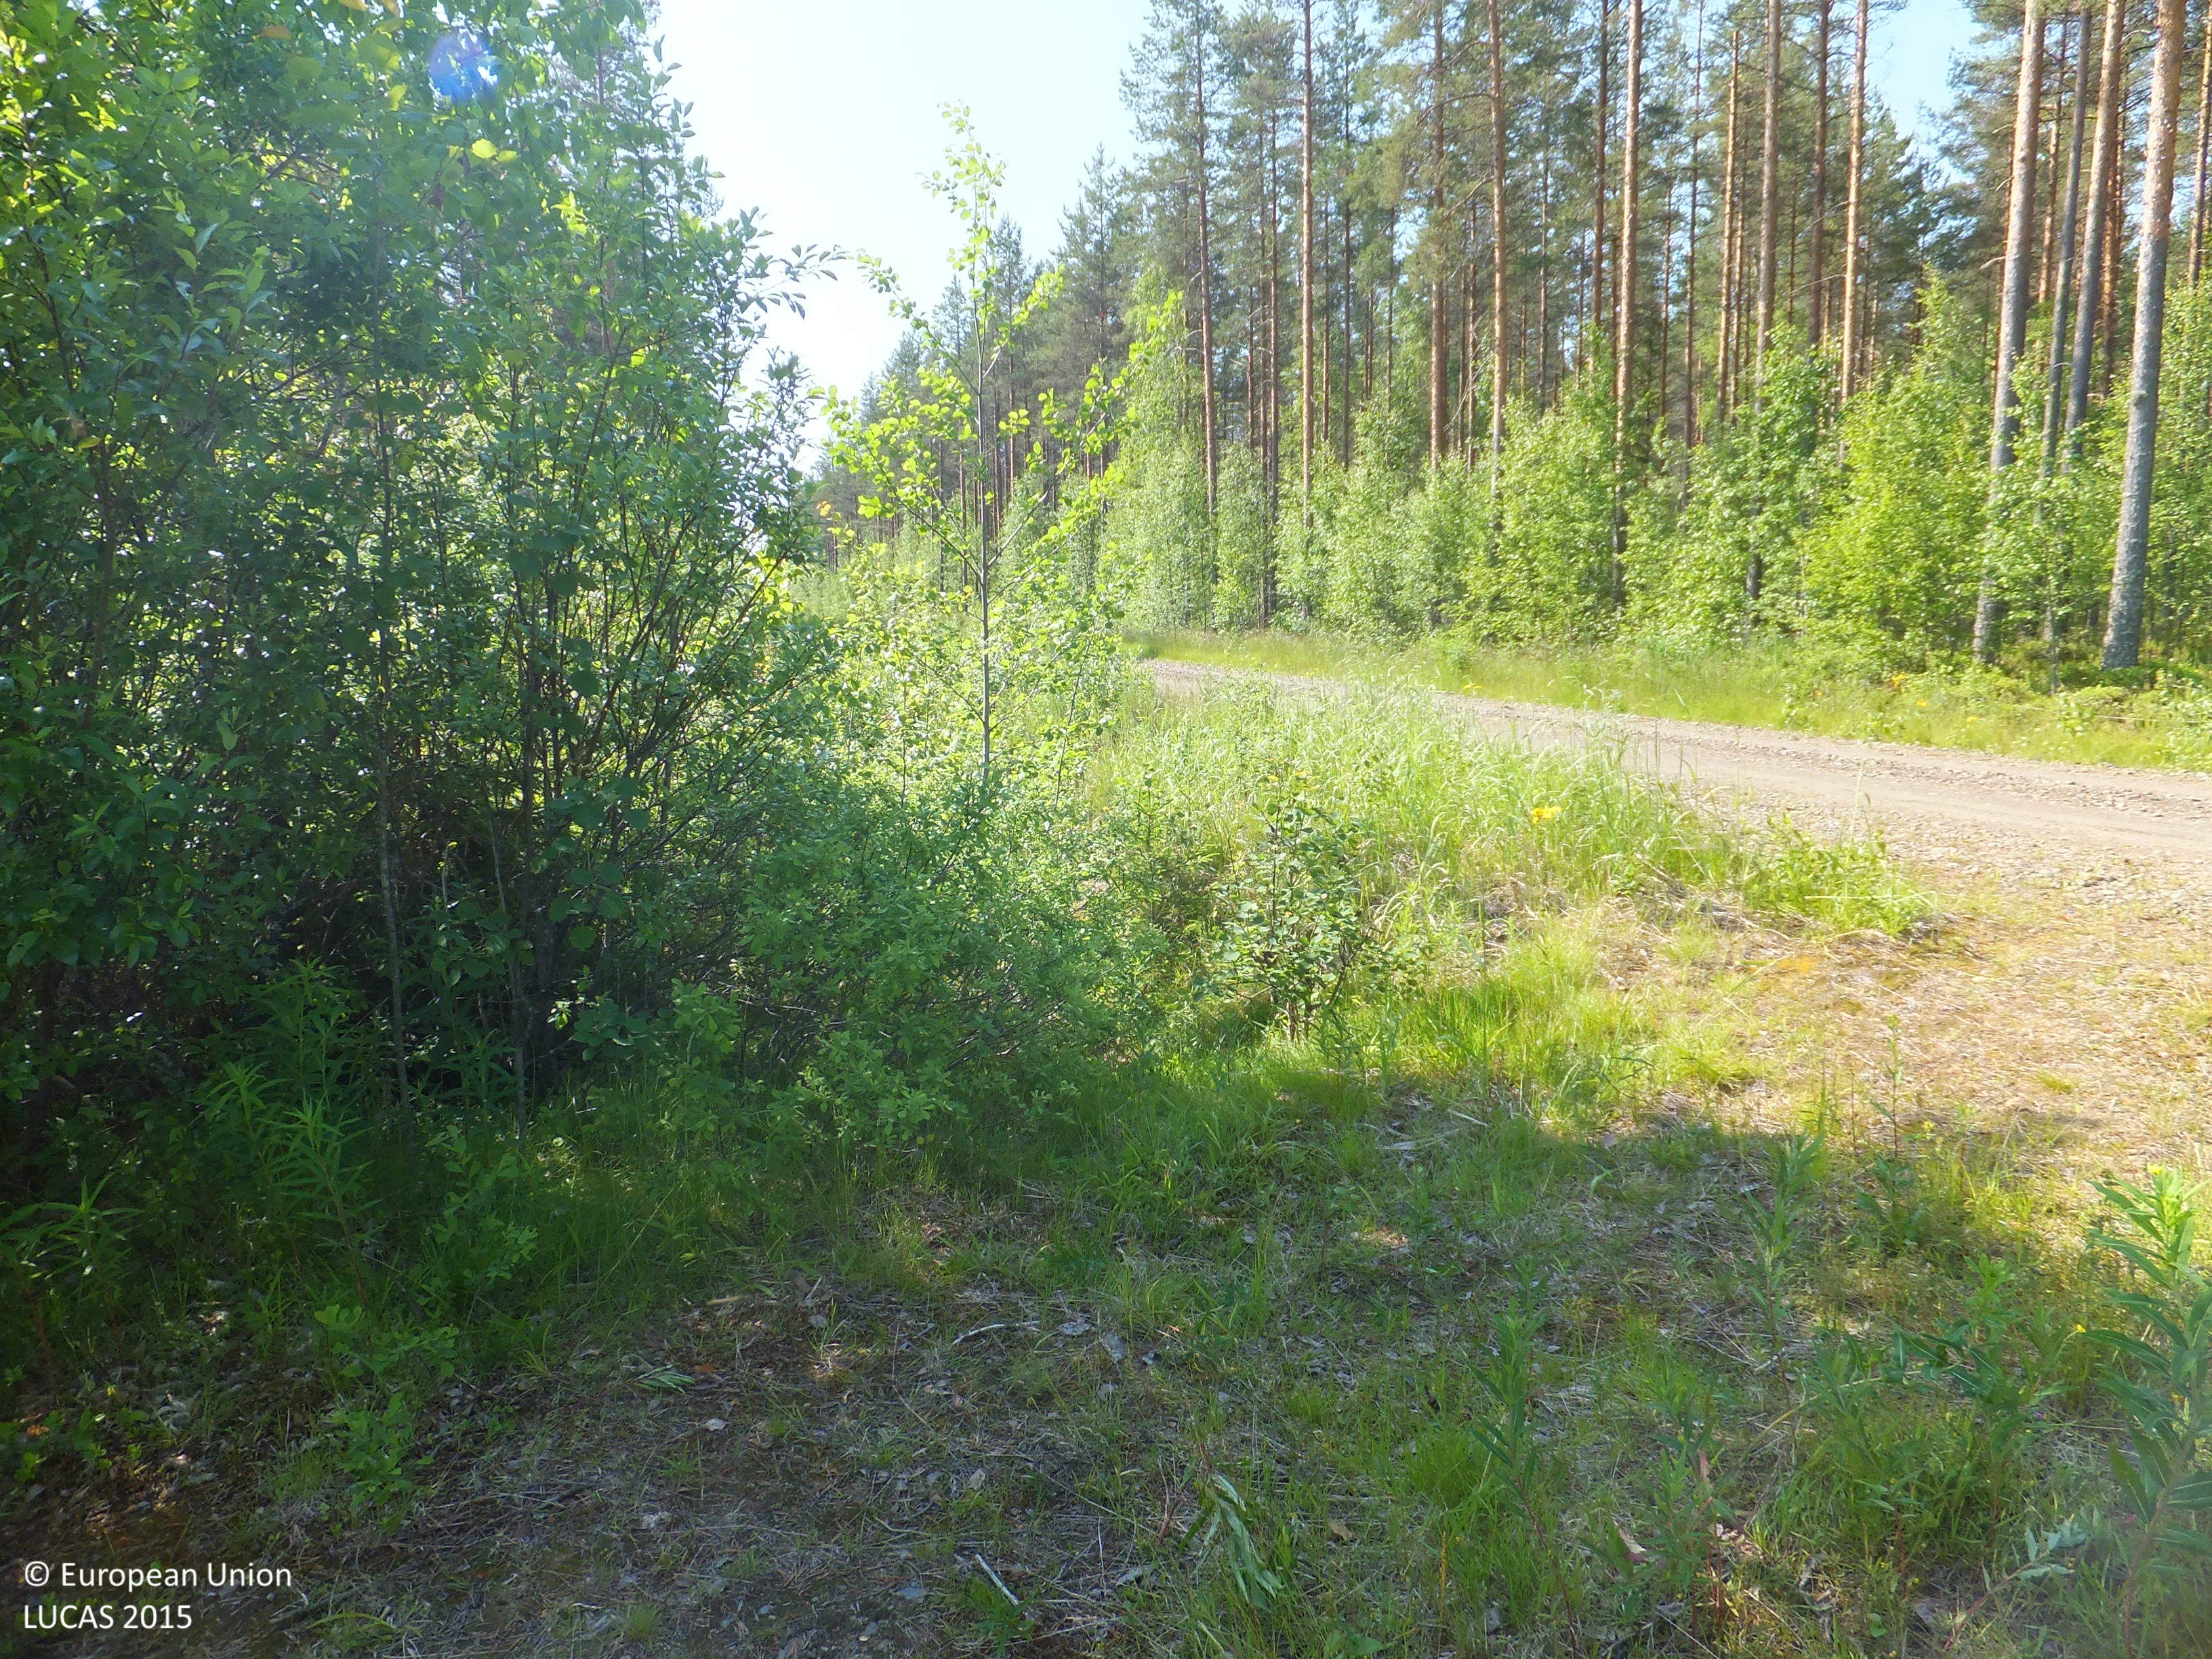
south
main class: Woodland
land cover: Pine dominated mixed woodland
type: boreal forest
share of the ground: 25 - 50 %
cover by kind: coniferous forest trees 20 %, broadleaved forest trees 20 %, herbaceous plants 20 %, unconsolidated bare surface 20 %, shrubs 10 %, lichens and mosses 10 %
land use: Forestry
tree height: < 5 m
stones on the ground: < 10 %
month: July
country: FI
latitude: 63.2977
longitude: 23.7720
